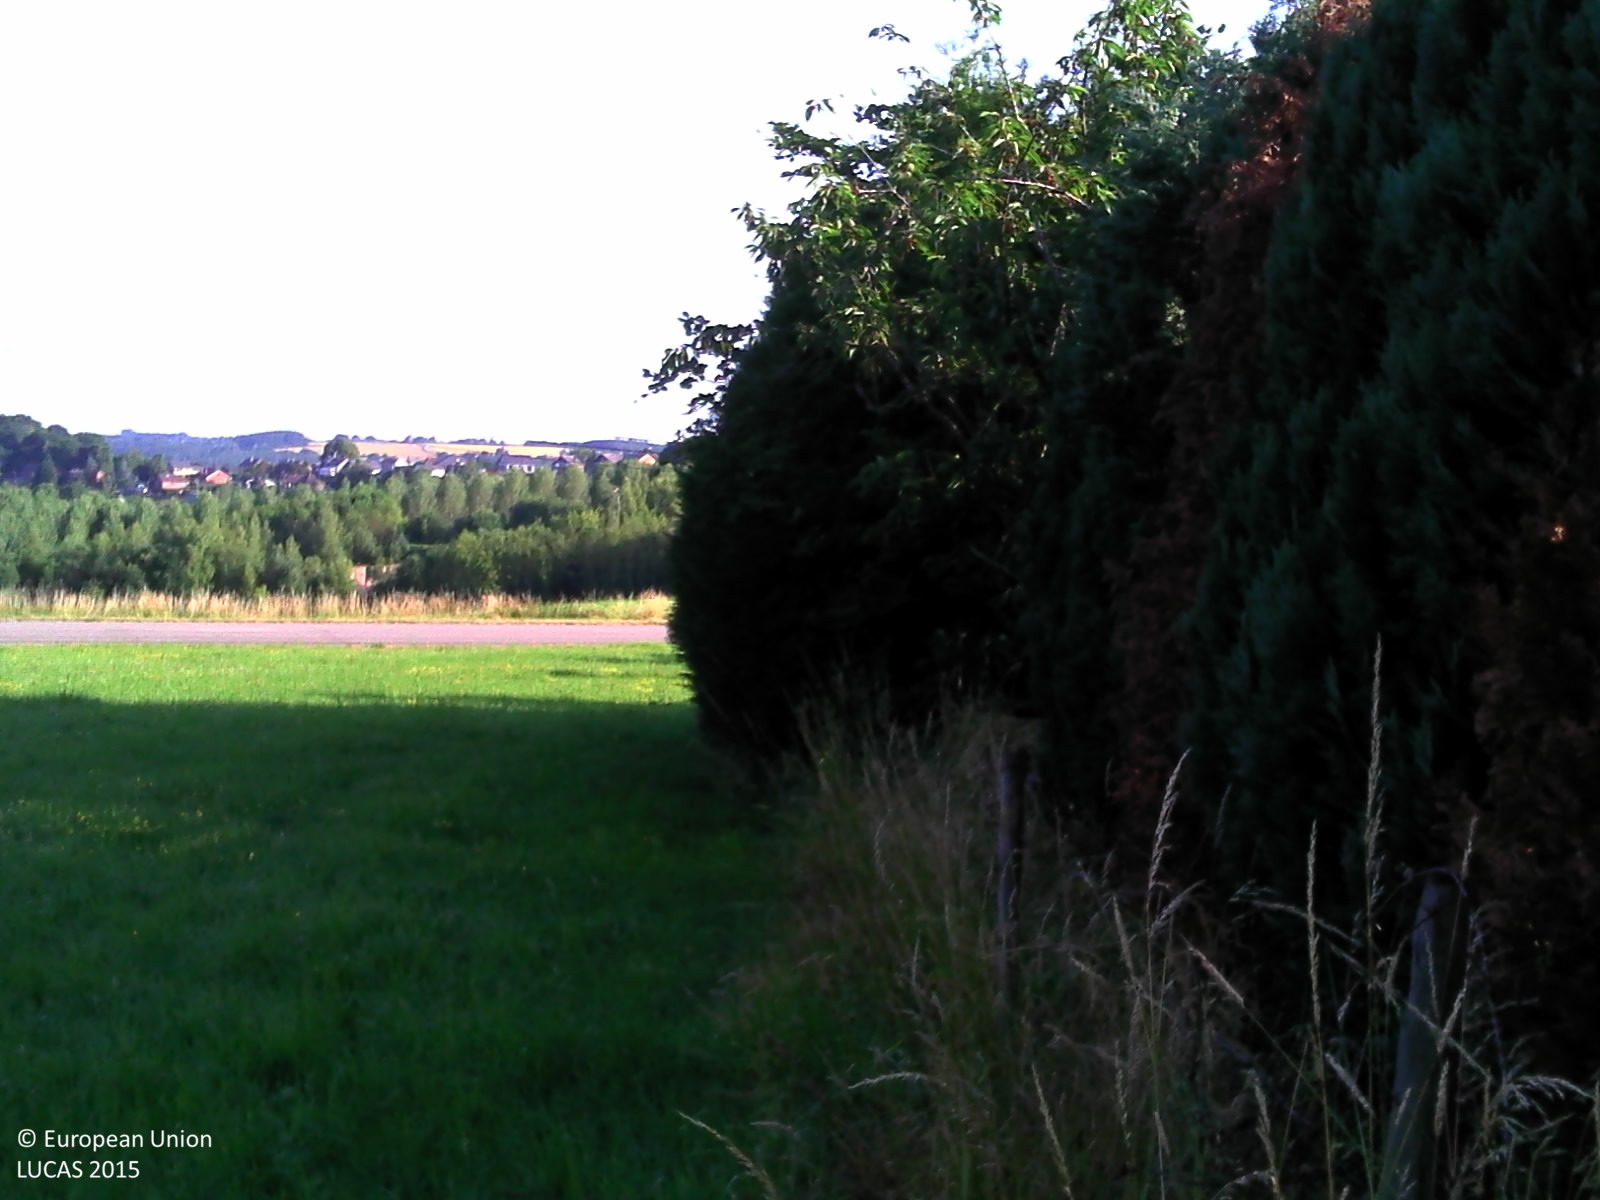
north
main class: Grassland
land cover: Grassland with sparse tree/shrub cover
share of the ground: > 75 %
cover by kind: herbaceous plants 95 %, broadleaved forest trees 5 %
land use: Residential
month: July
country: BE
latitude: 50.3365
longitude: 4.8124
